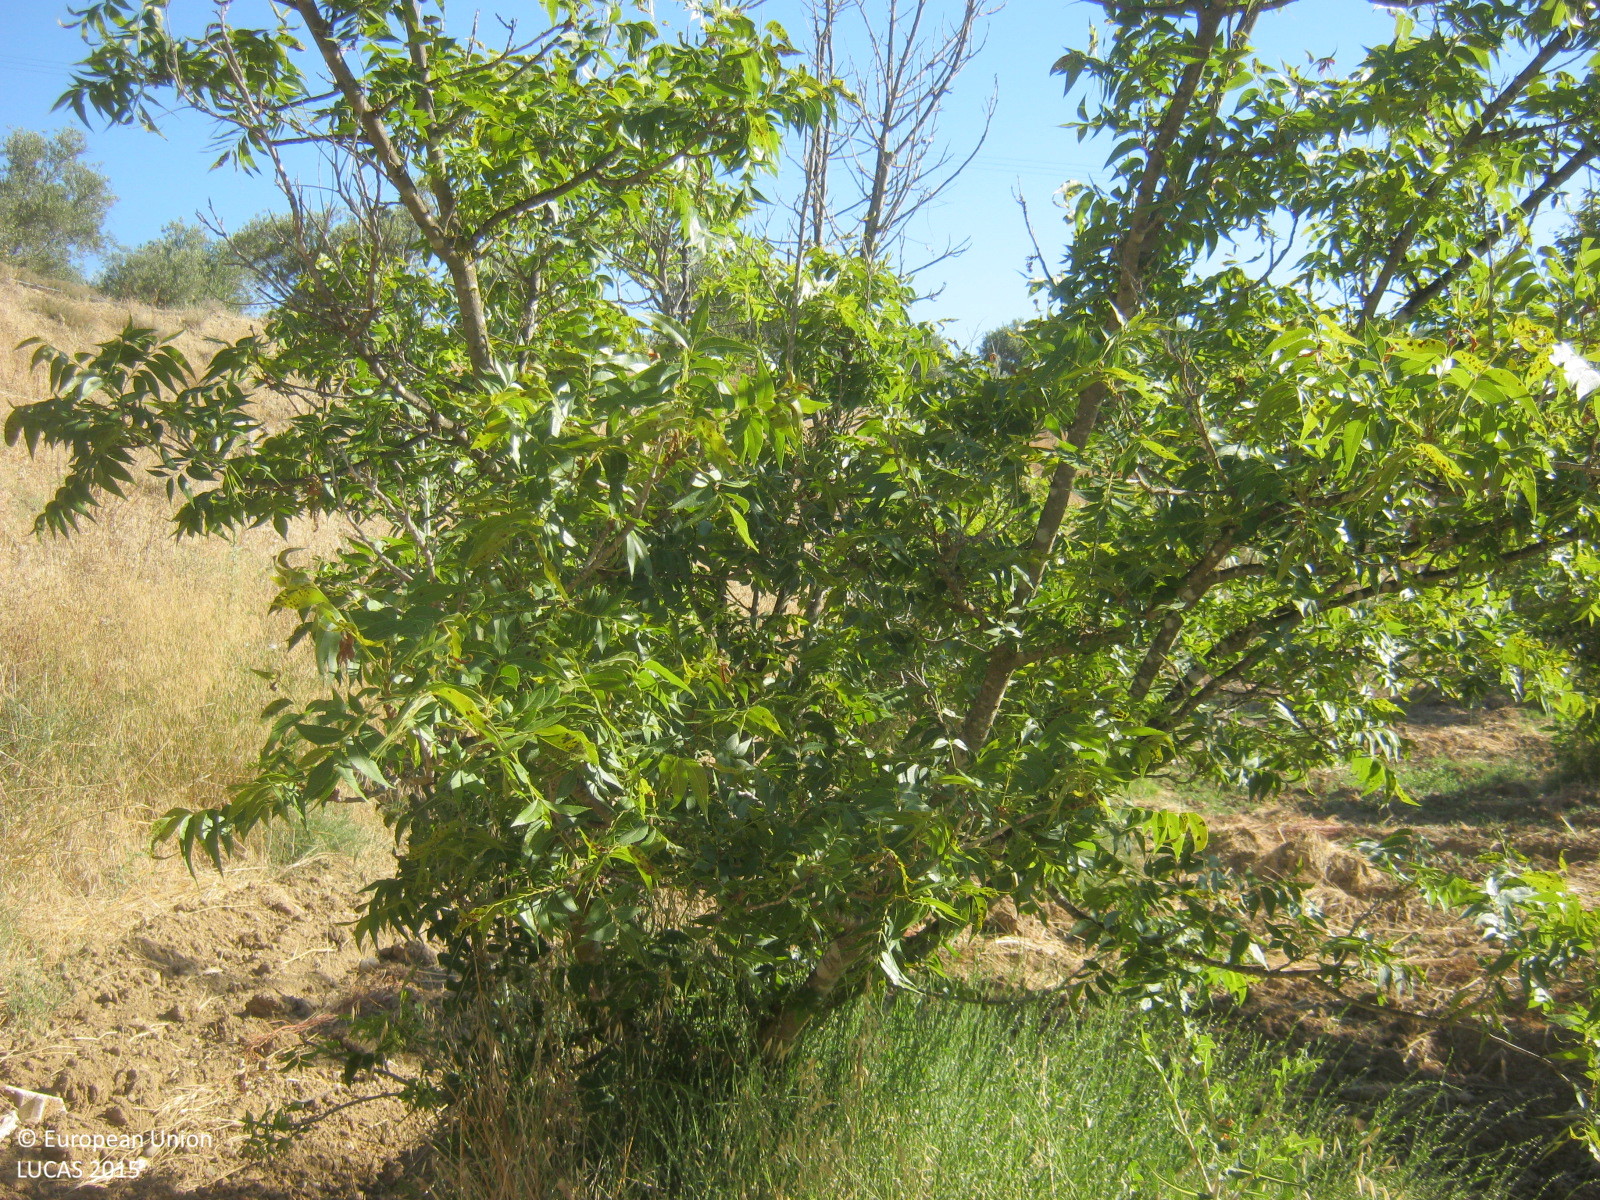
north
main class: Cropland
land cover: Nuts trees
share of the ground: 10 - 25 %
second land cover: Other bare soil
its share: > 75 %
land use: Agriculture (excluding fallow land and kitchen gardens)
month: June
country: CY
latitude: 35.1017
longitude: 33.1896
